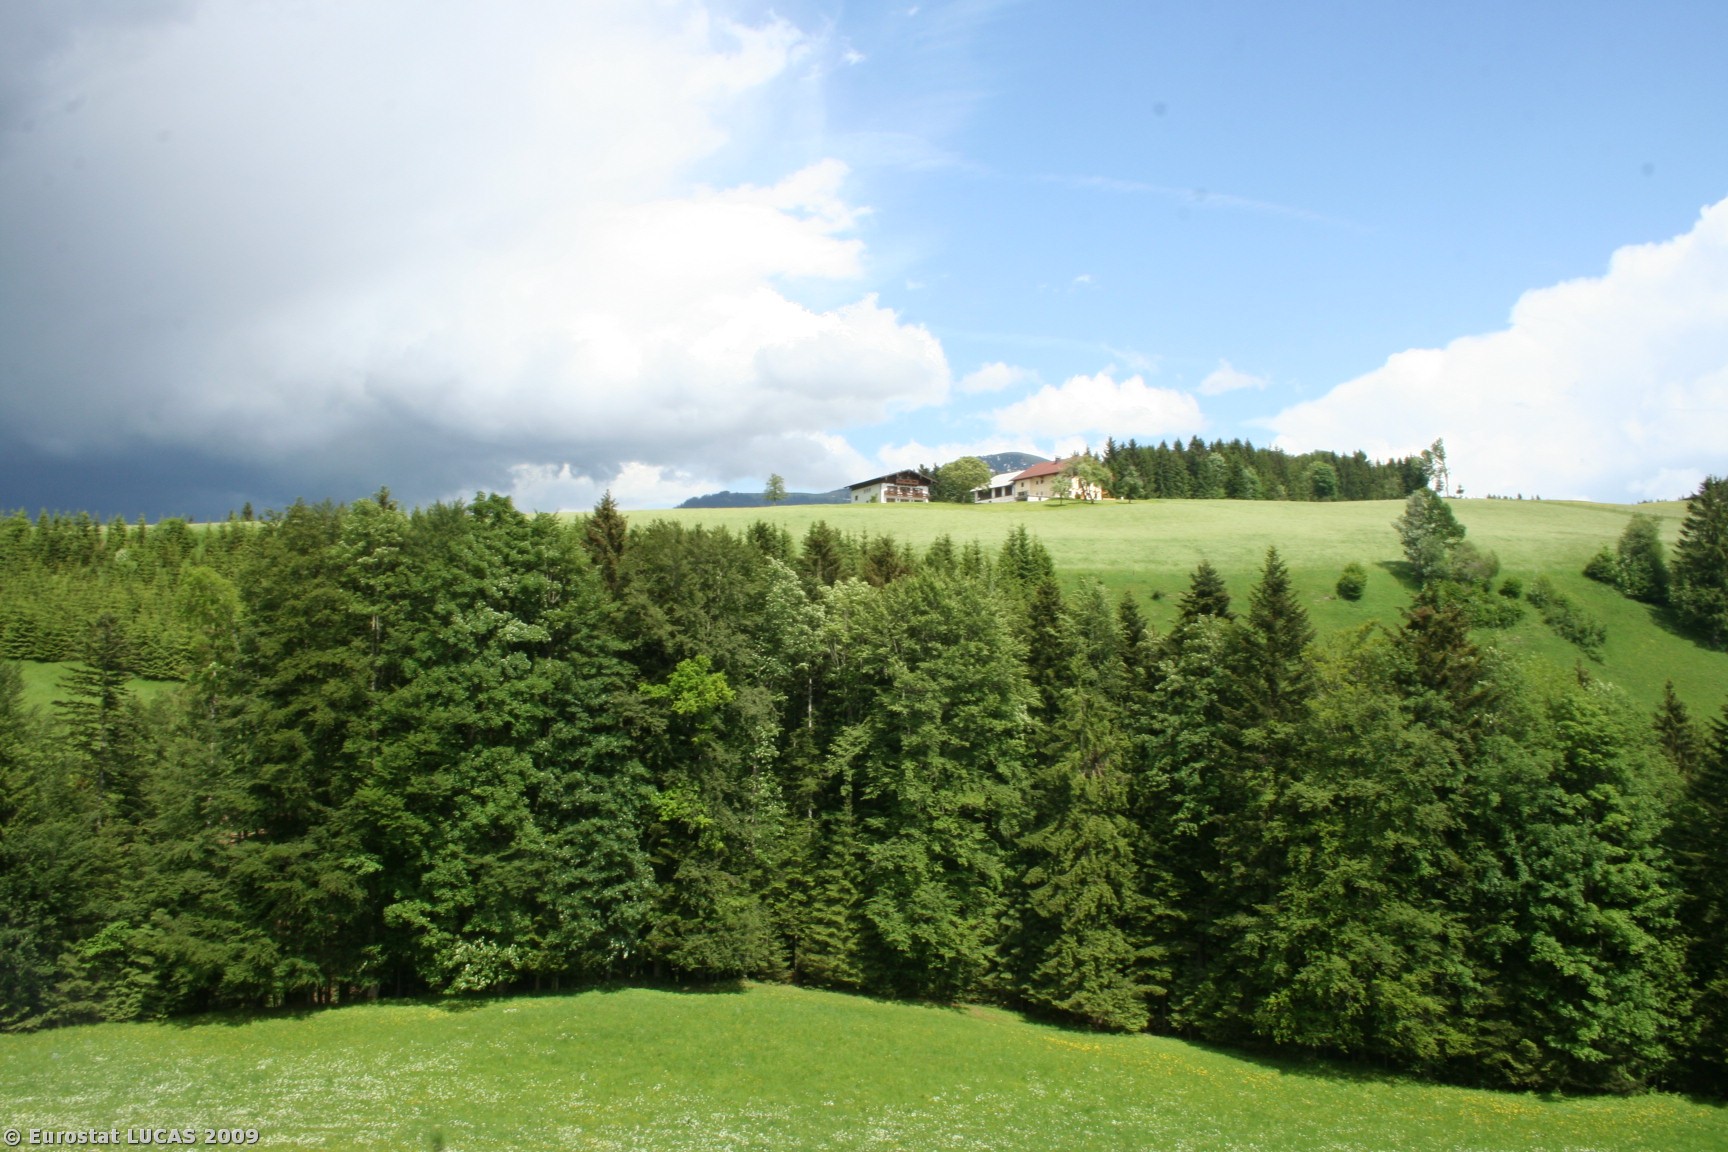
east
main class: Grassland
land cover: Grassland without tree/shrub cover
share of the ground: > 75 %
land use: Agriculture (excluding fallow land and kitchen gardens)
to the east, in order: Grassland without tree/shrub cover; Mixed woodland; Rivers and streams; Mixed woodland; Grassland without tree/shrub cover
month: May
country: AT
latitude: 47.6366
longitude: 13.2061
